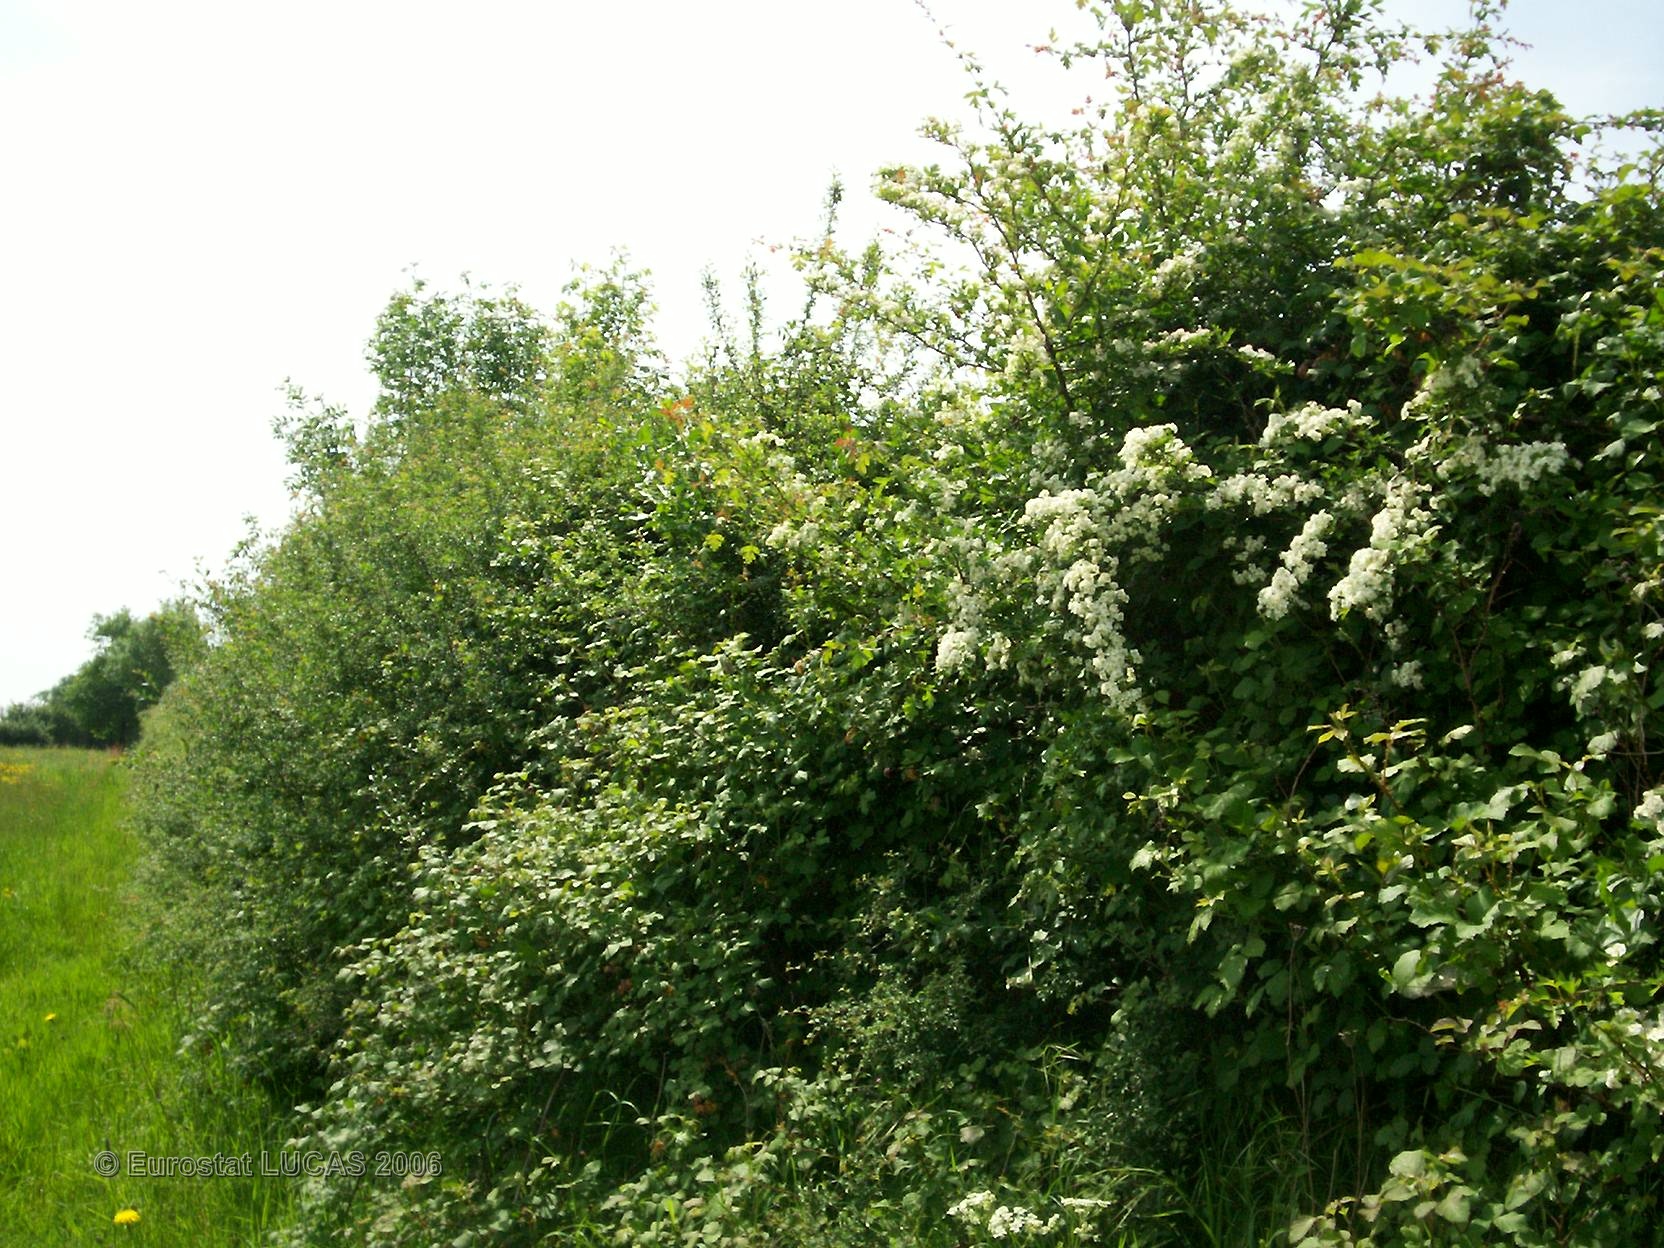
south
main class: Grassland
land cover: Grassland without tree/shrub cover
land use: Agriculture (excluding fallow land and kitchen gardens)
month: May
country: FR
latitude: 46.5232
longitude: -0.3100
